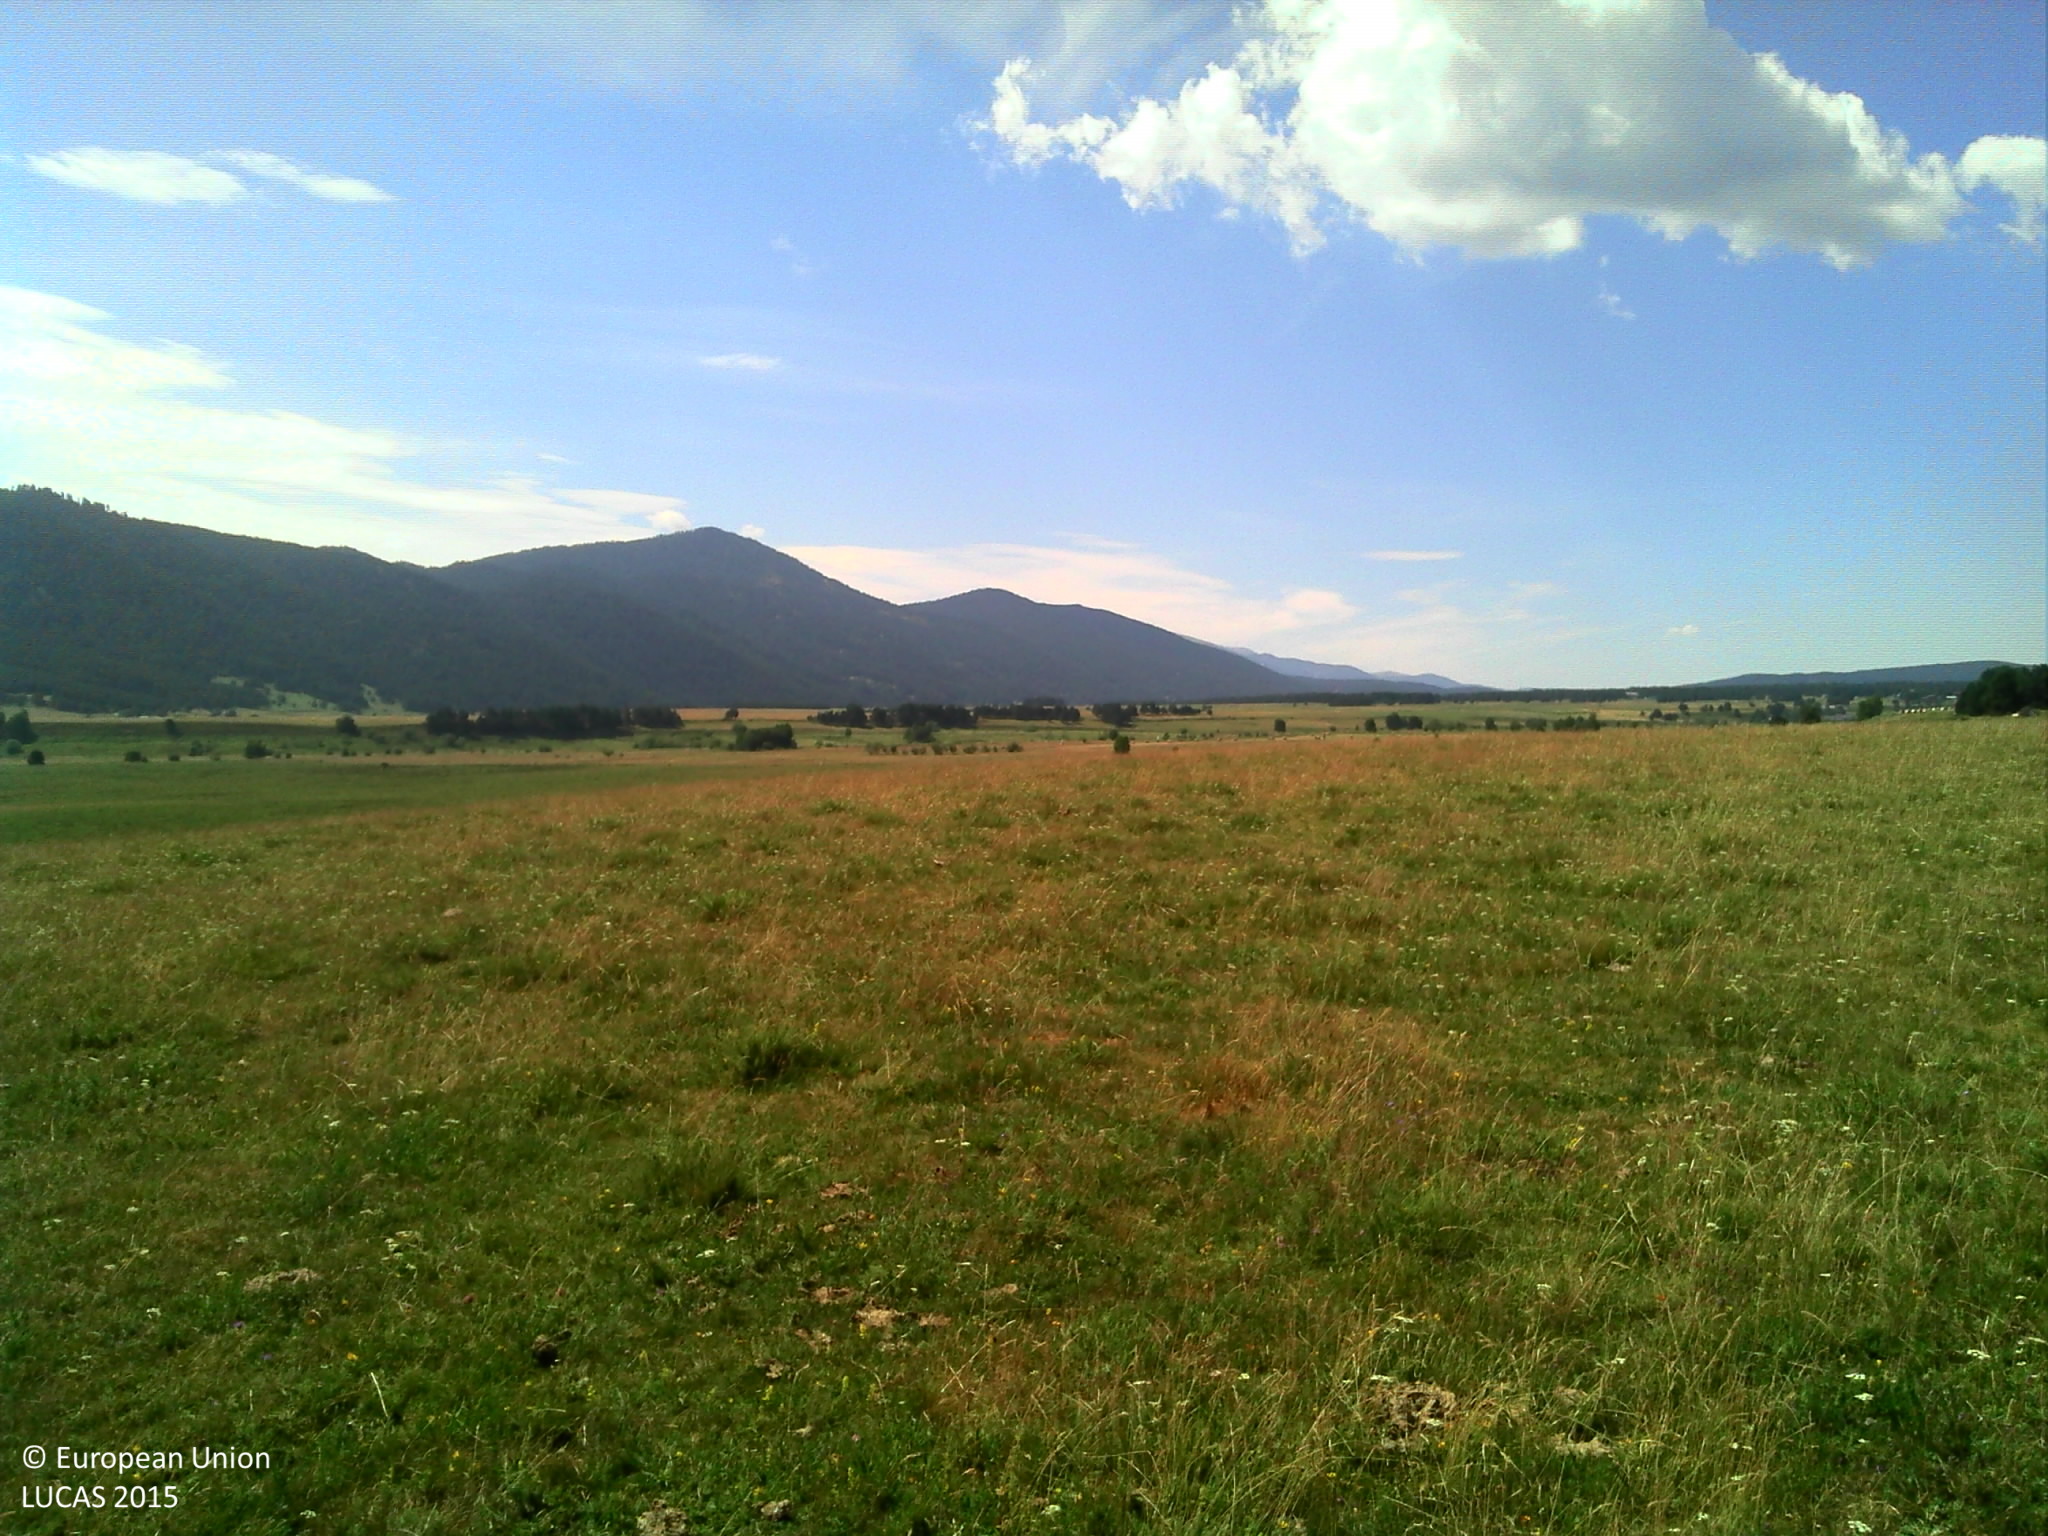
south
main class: Grassland
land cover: Grassland without tree/shrub cover
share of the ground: > 75 %
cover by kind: herbaceous plants 100 %
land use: Agriculture (excluding fallow land and kitchen gardens)
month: July
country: FR
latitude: 42.6369
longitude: 2.1202
